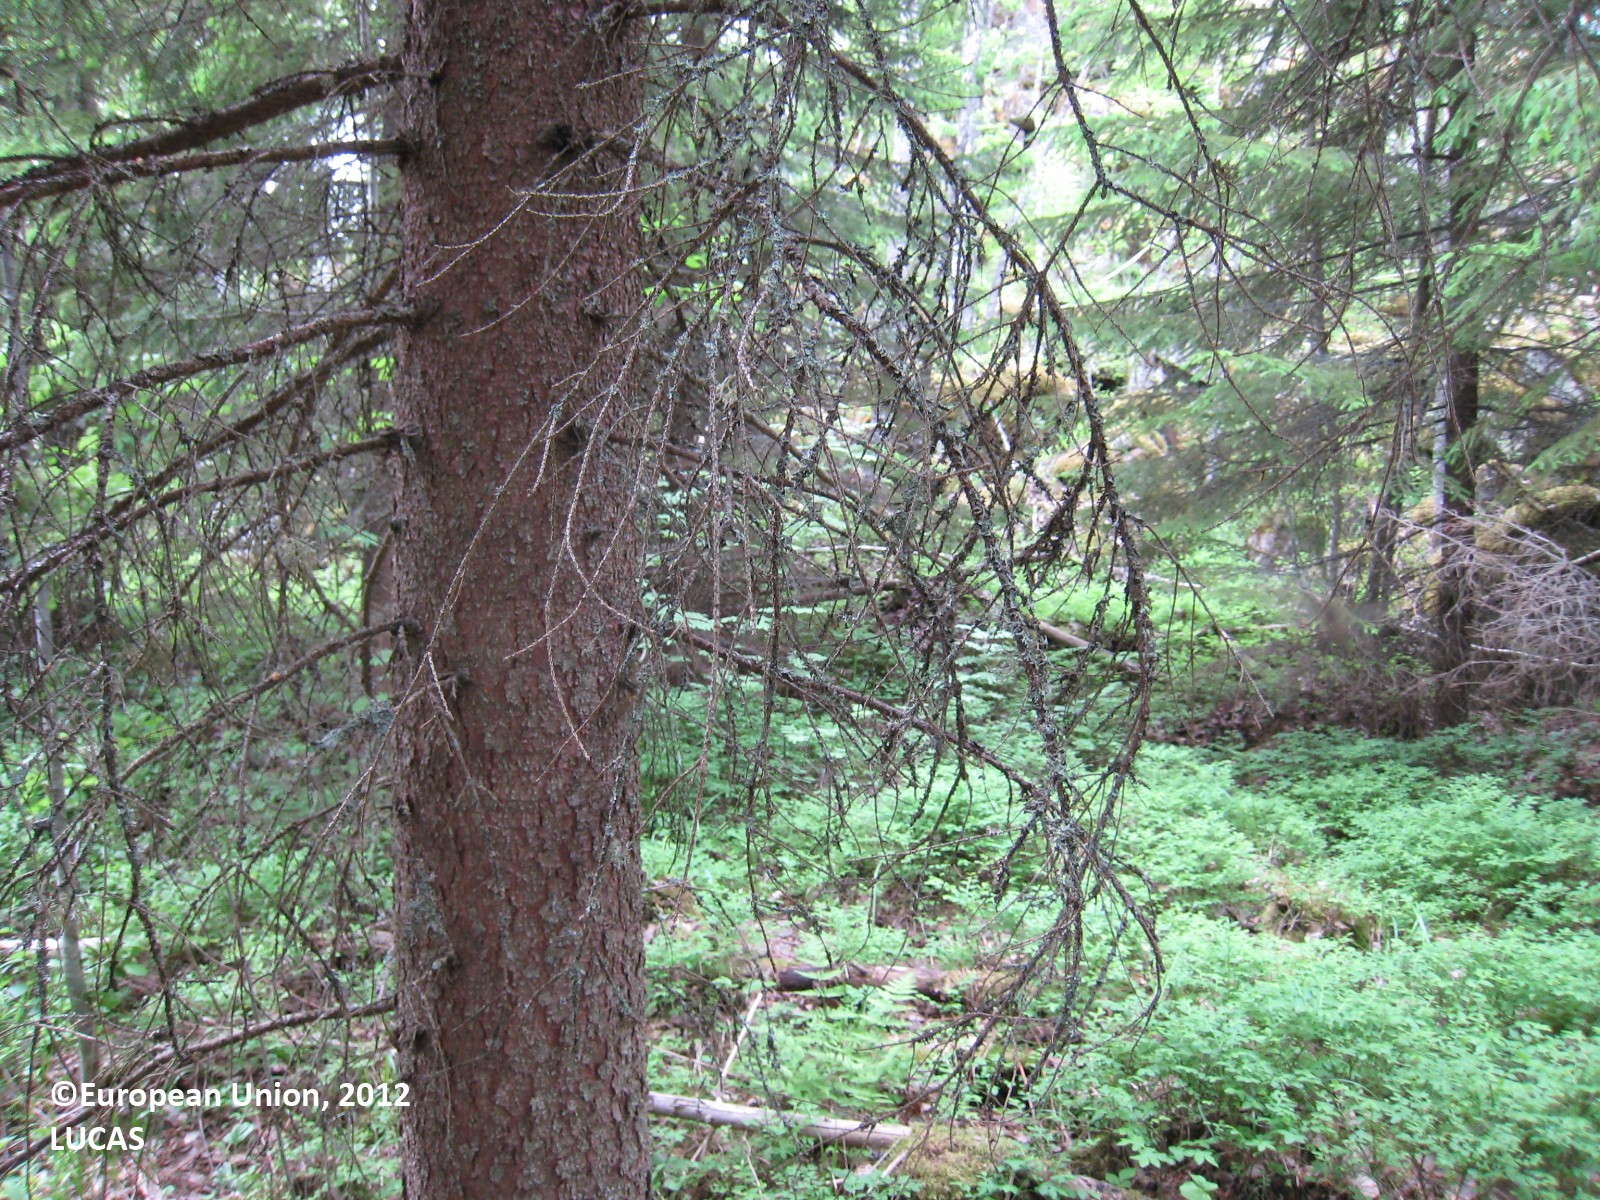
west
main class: Woodland
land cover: Spruce dominated mixed woodland
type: boreal forest
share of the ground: 50 - 75 %
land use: Forestry
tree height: > 5 m
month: June
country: FI
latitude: 61.6236
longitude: 25.9564
